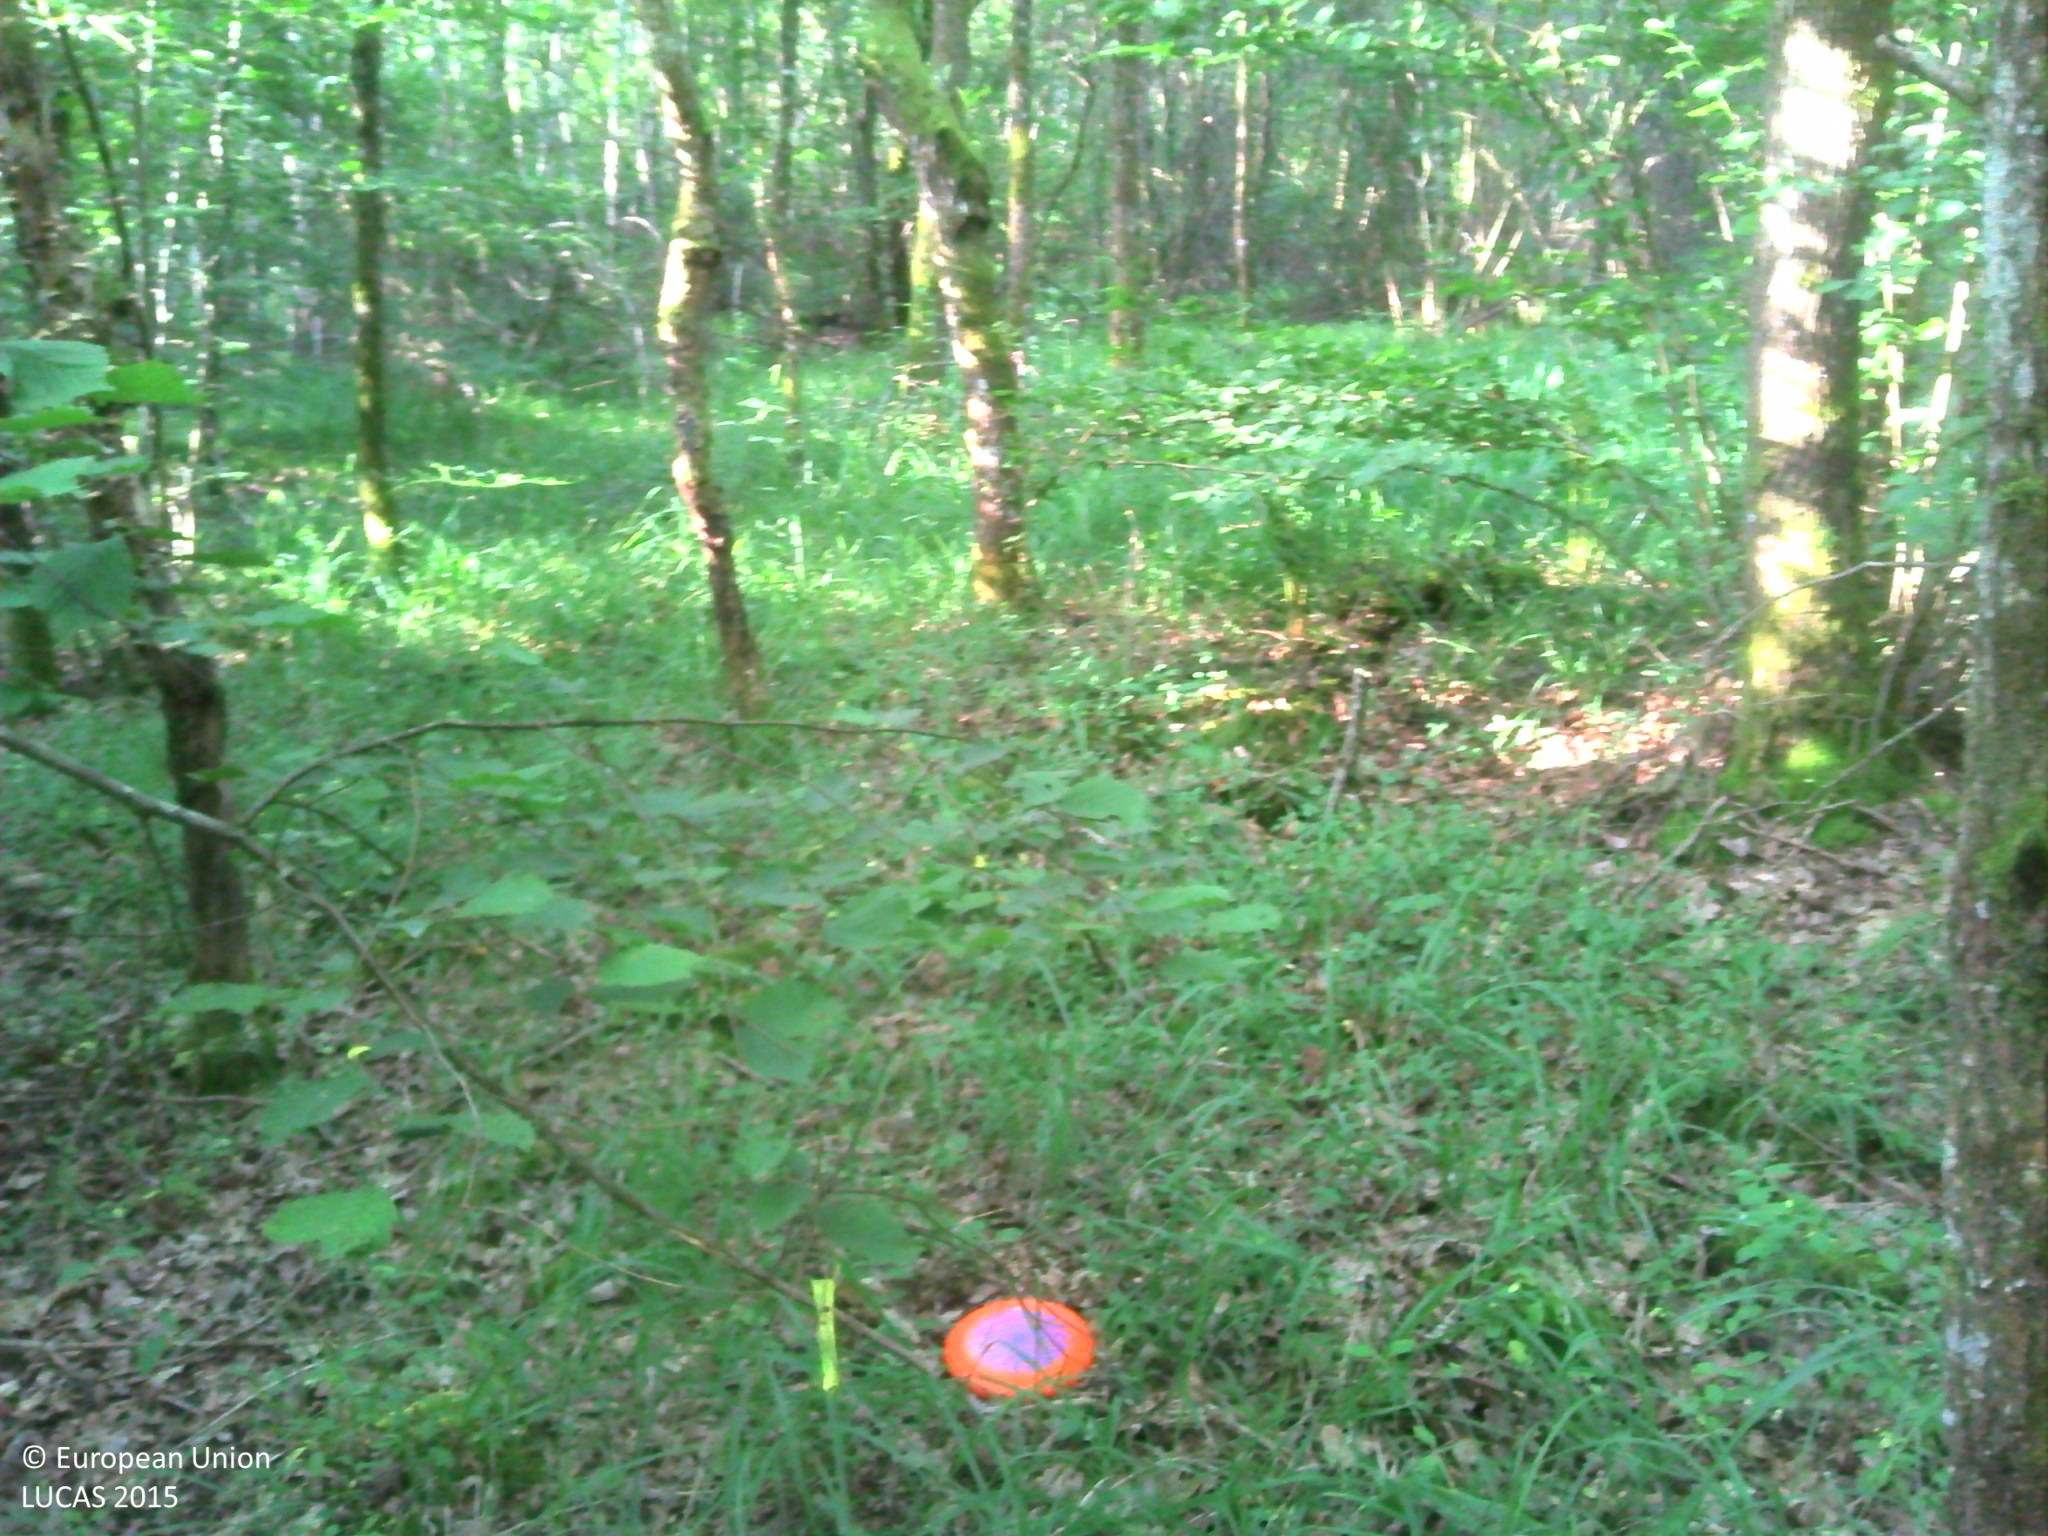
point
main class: Woodland
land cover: Broadleaved woodland
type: acidophilous oak and oak-birch forest
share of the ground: > 75 %
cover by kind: broadleaved forest trees 85 %, herbaceous plants 15 %
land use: Forestry
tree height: > 5 m
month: July
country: FR
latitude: 46.9844
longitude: 5.2289
